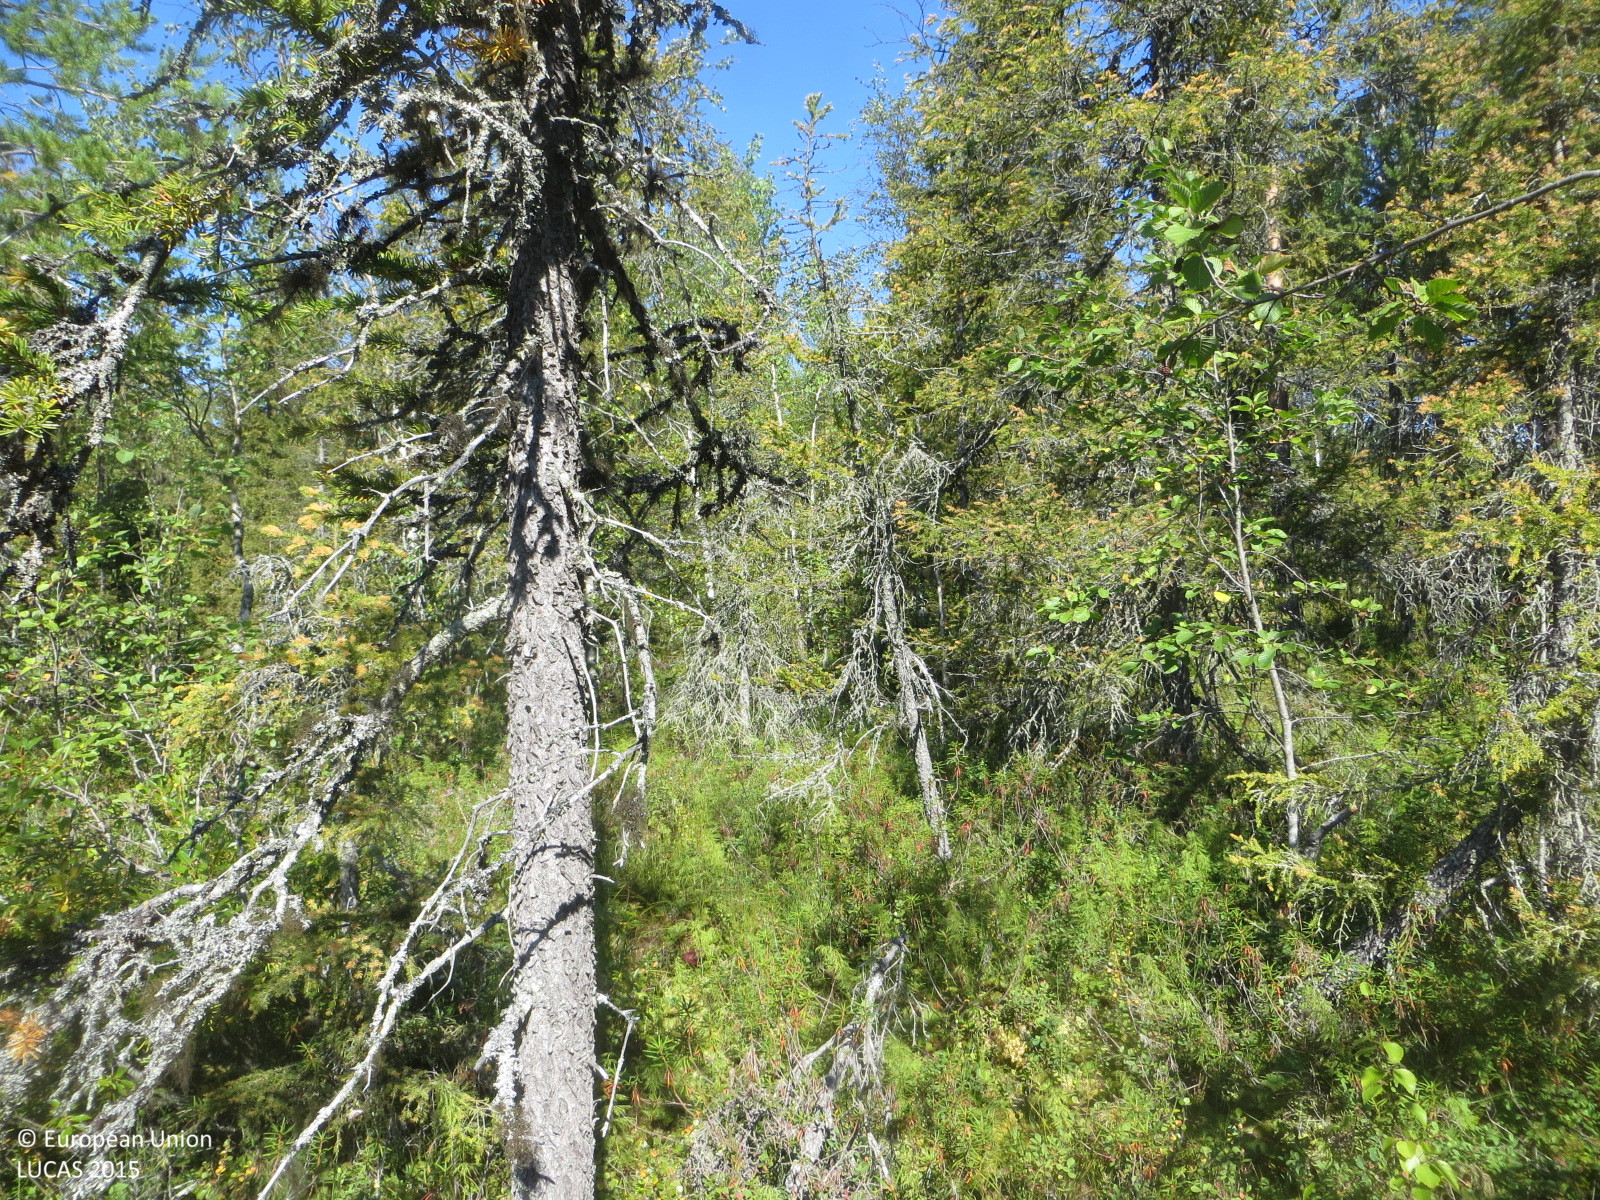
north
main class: Woodland
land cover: Spruce dominated mixed woodland
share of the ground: 50 - 75 %
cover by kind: shrubs 50 %, coniferous forest trees 25 %, broadleaved forest trees 25 %
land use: Forestry
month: August
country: FI
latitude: 67.1733
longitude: 23.9087
